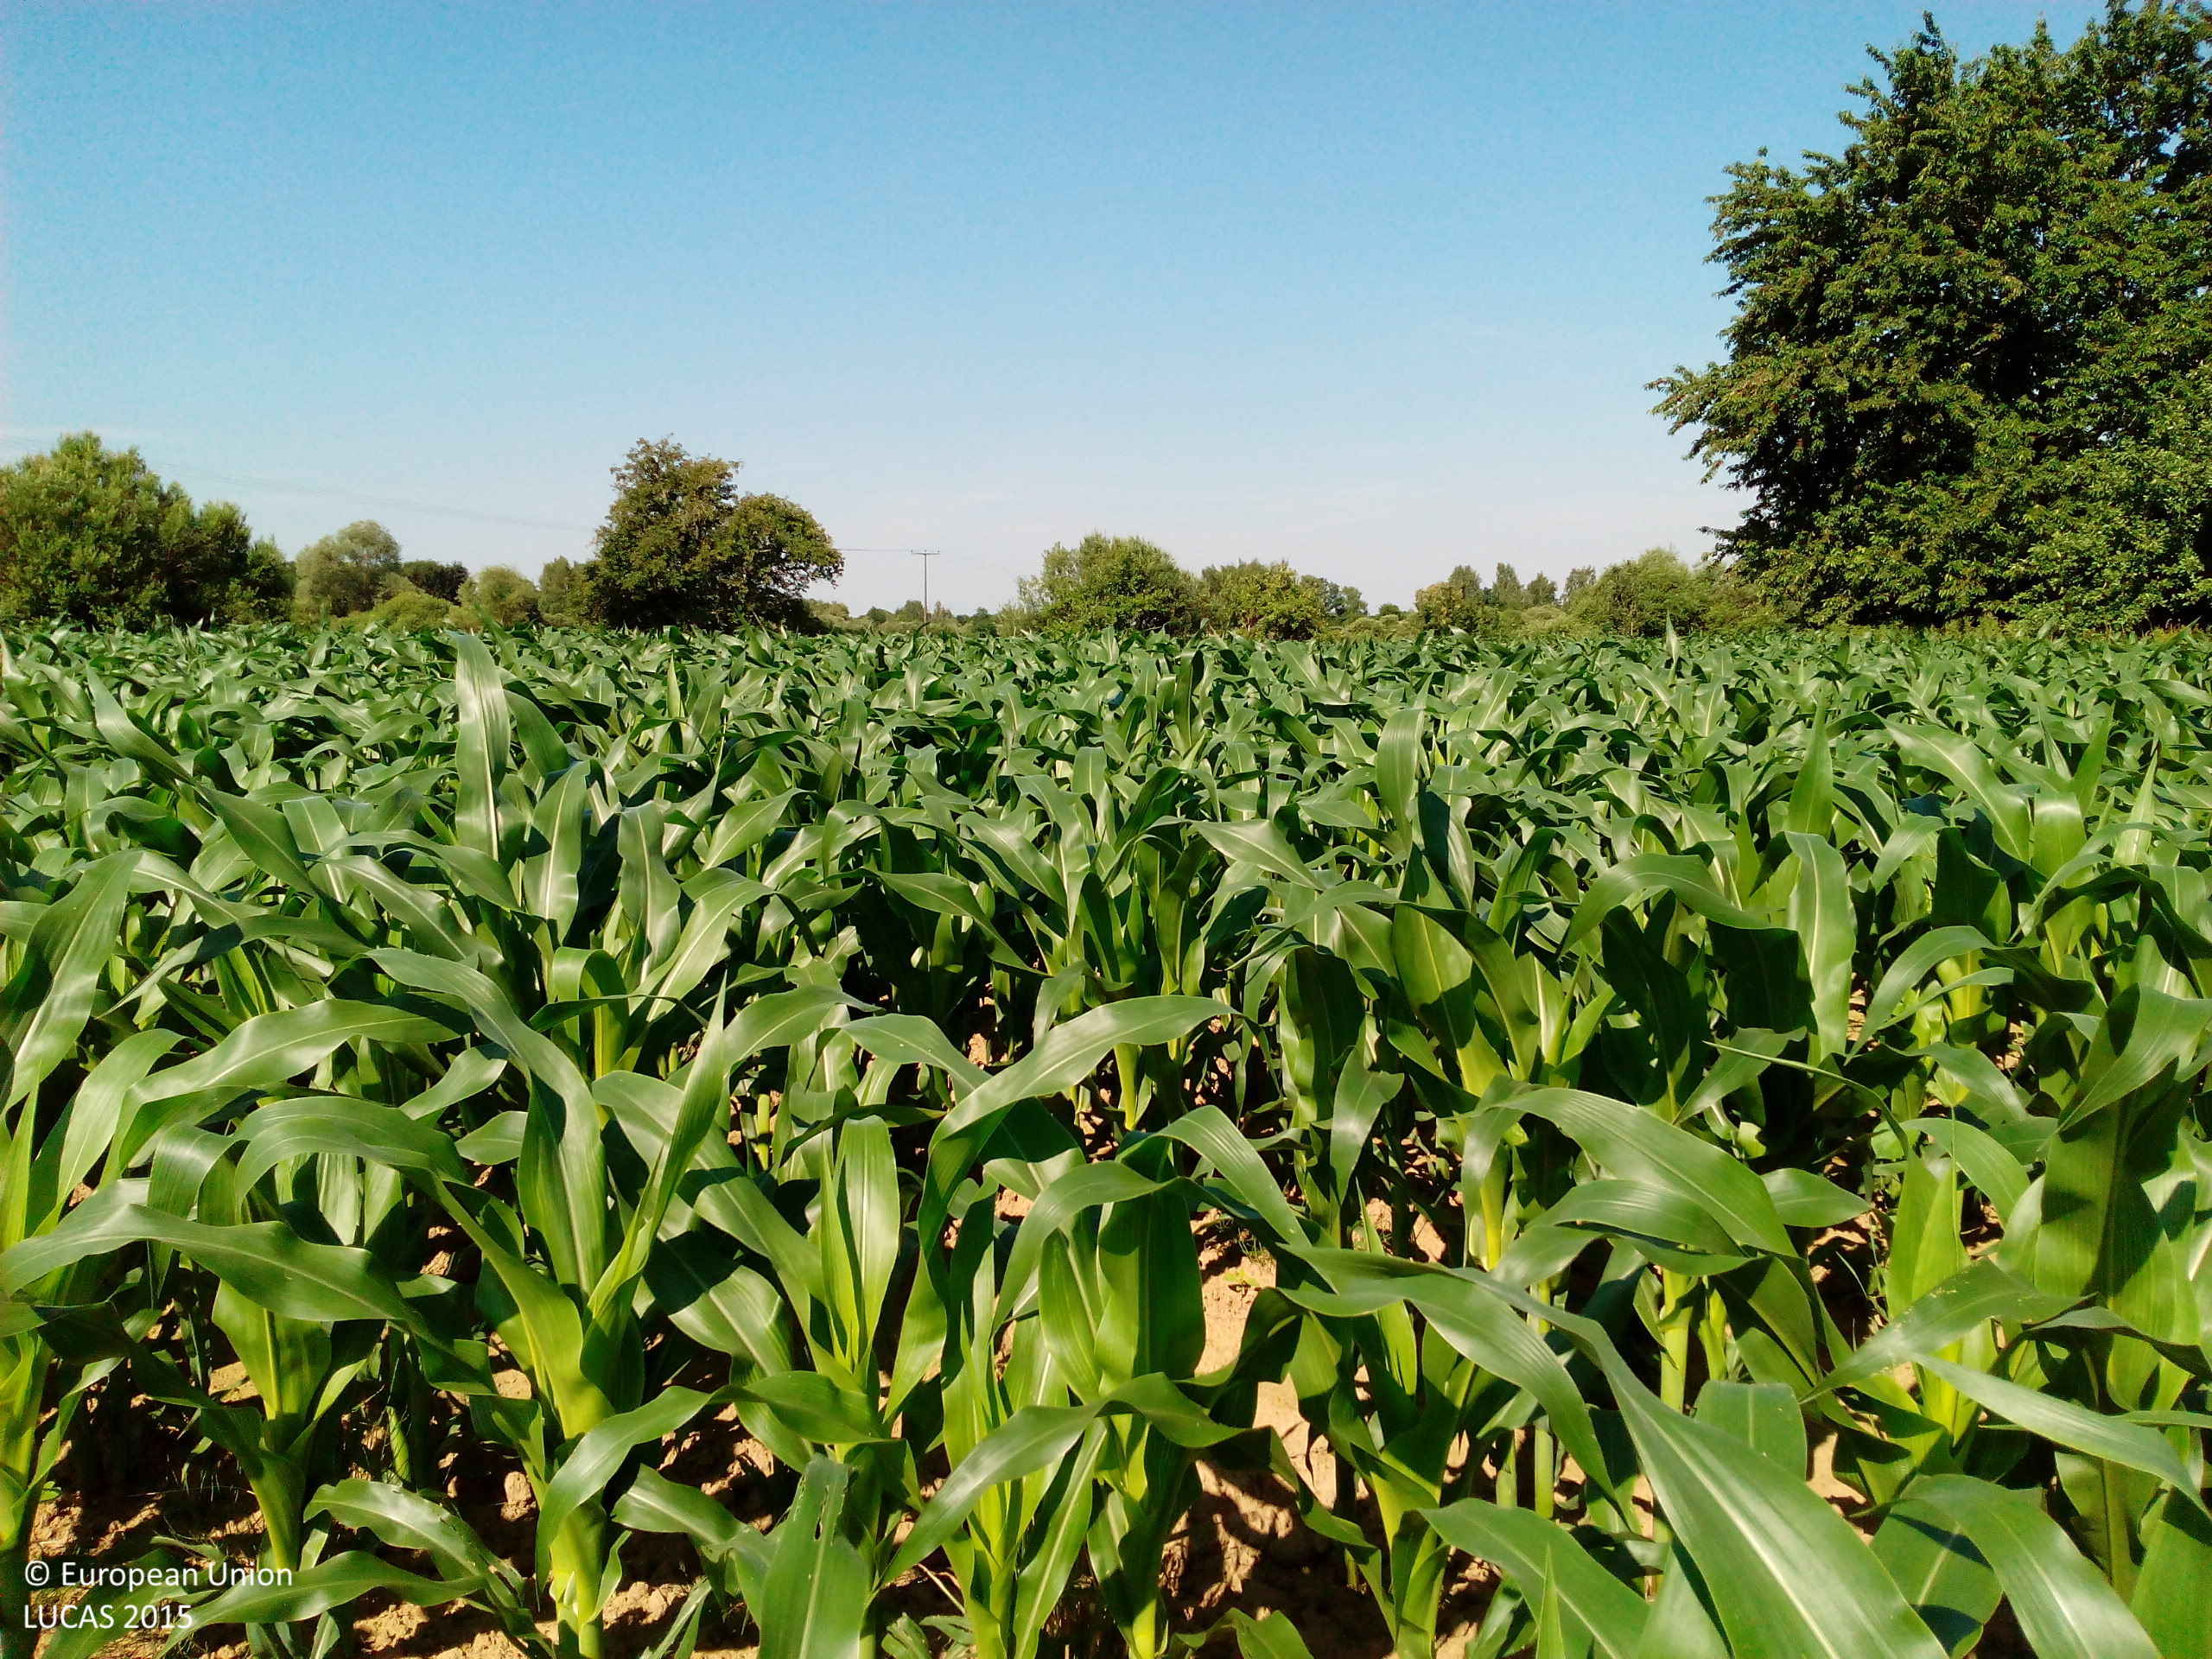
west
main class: Cropland
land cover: Maize
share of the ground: > 75 %
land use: Agriculture (excluding fallow land and kitchen gardens)
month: June
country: DE
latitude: 48.7482
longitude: 8.1647
